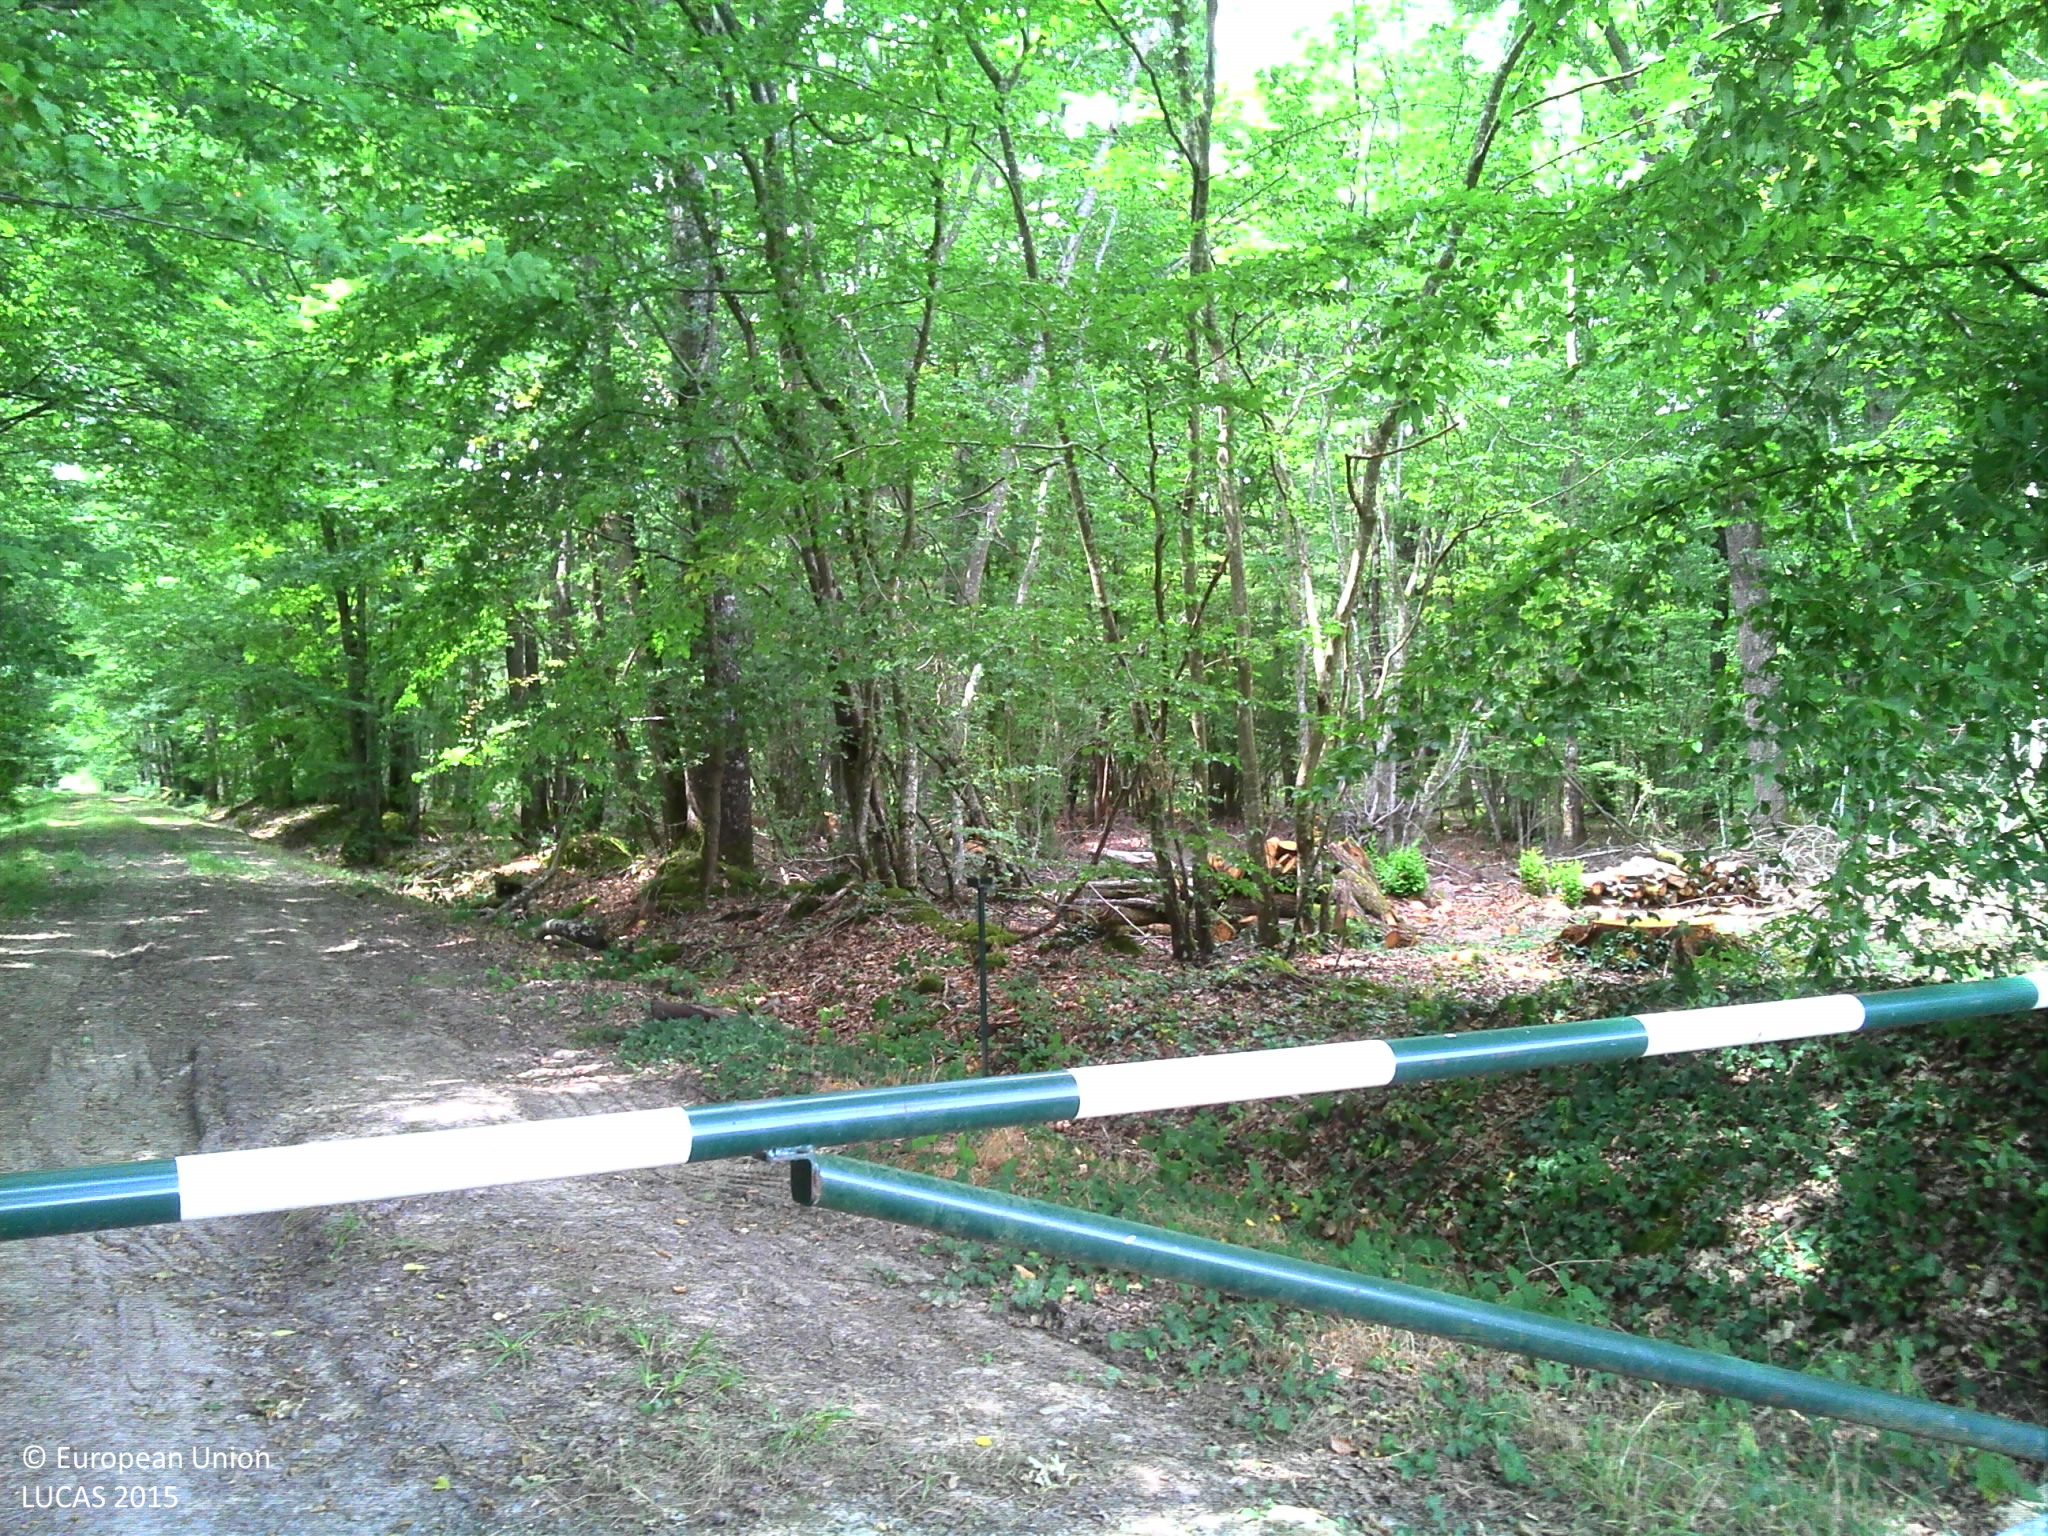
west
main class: Woodland
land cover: Broadleaved woodland
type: mesophytic deciduous forest
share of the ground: > 75 %
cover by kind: broadleaved forest trees 90 %, shrubs 5 %, herbaceous plants 5 %
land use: Forestry
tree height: > 5 m
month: July
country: FR
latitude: 46.6430
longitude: 2.9548
